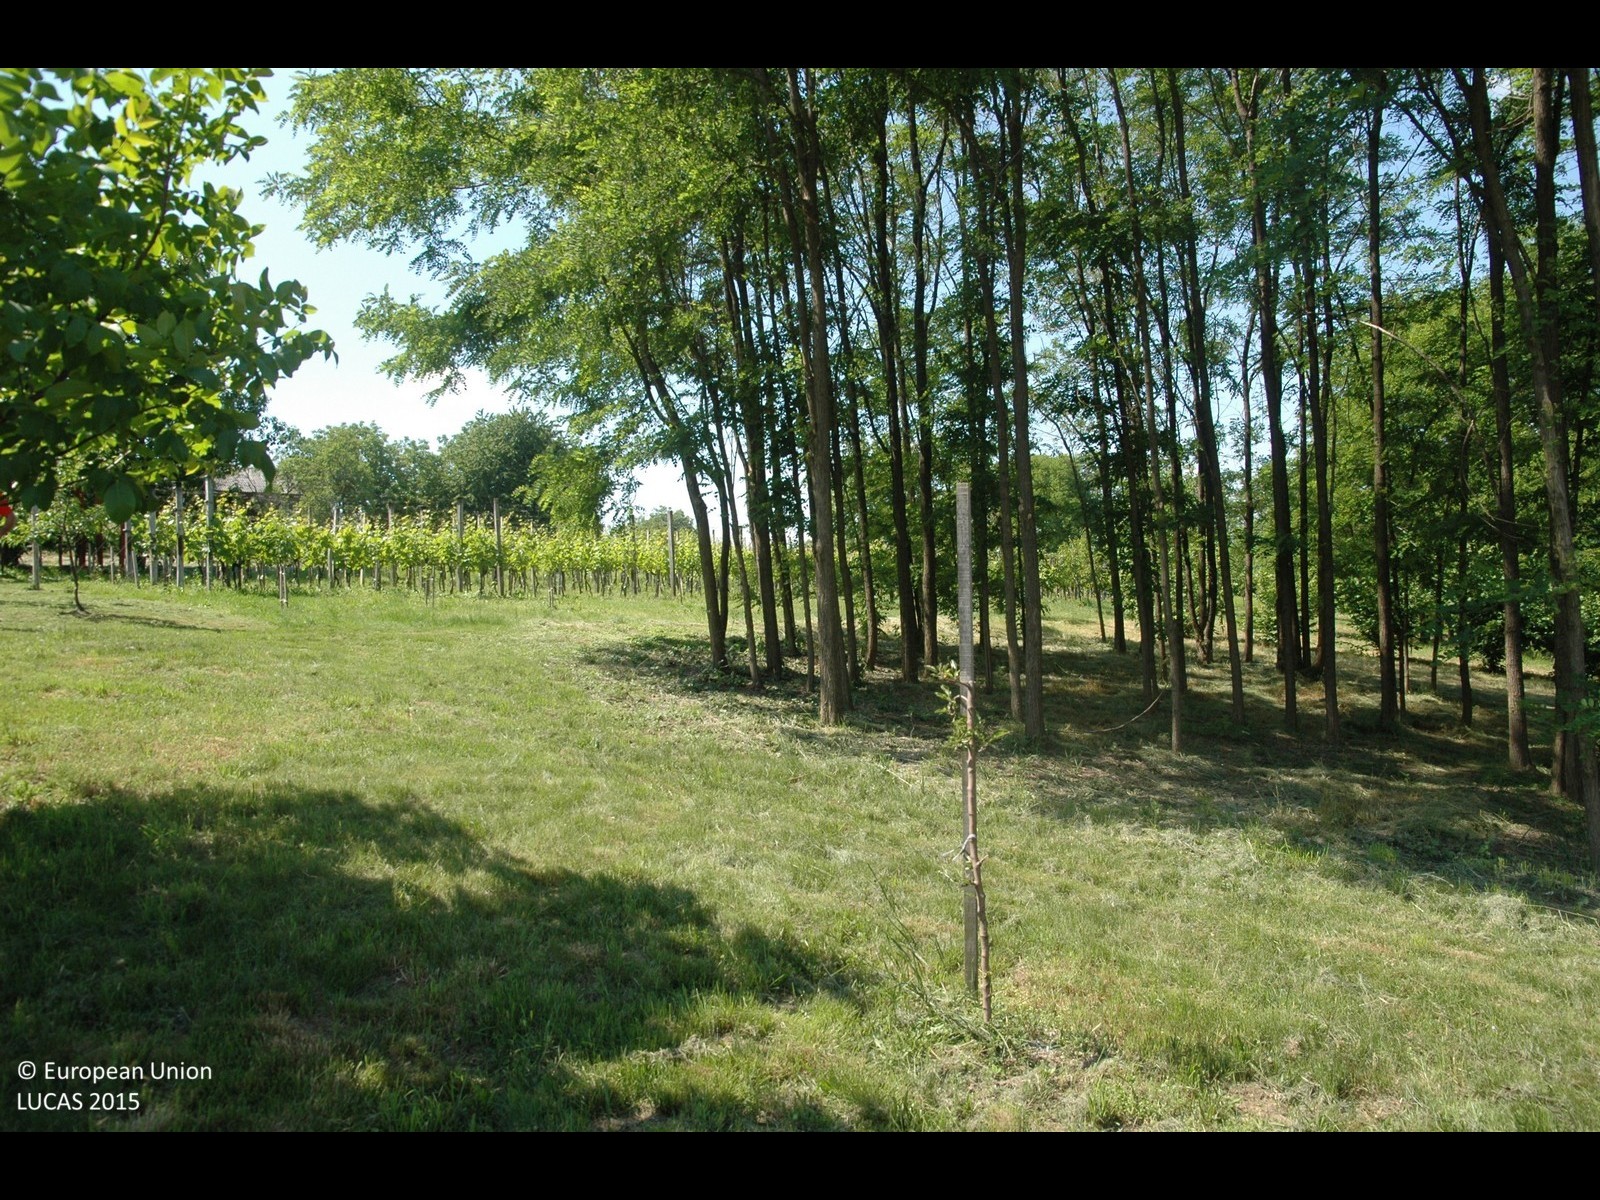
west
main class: Cropland
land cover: Nuts trees
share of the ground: 10 - 25 %
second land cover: Grassland without tree/shrub cover
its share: 50 - 75 %
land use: Agriculture (excluding fallow land and kitchen gardens)
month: May
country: HR
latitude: 46.4849
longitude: 16.3969
